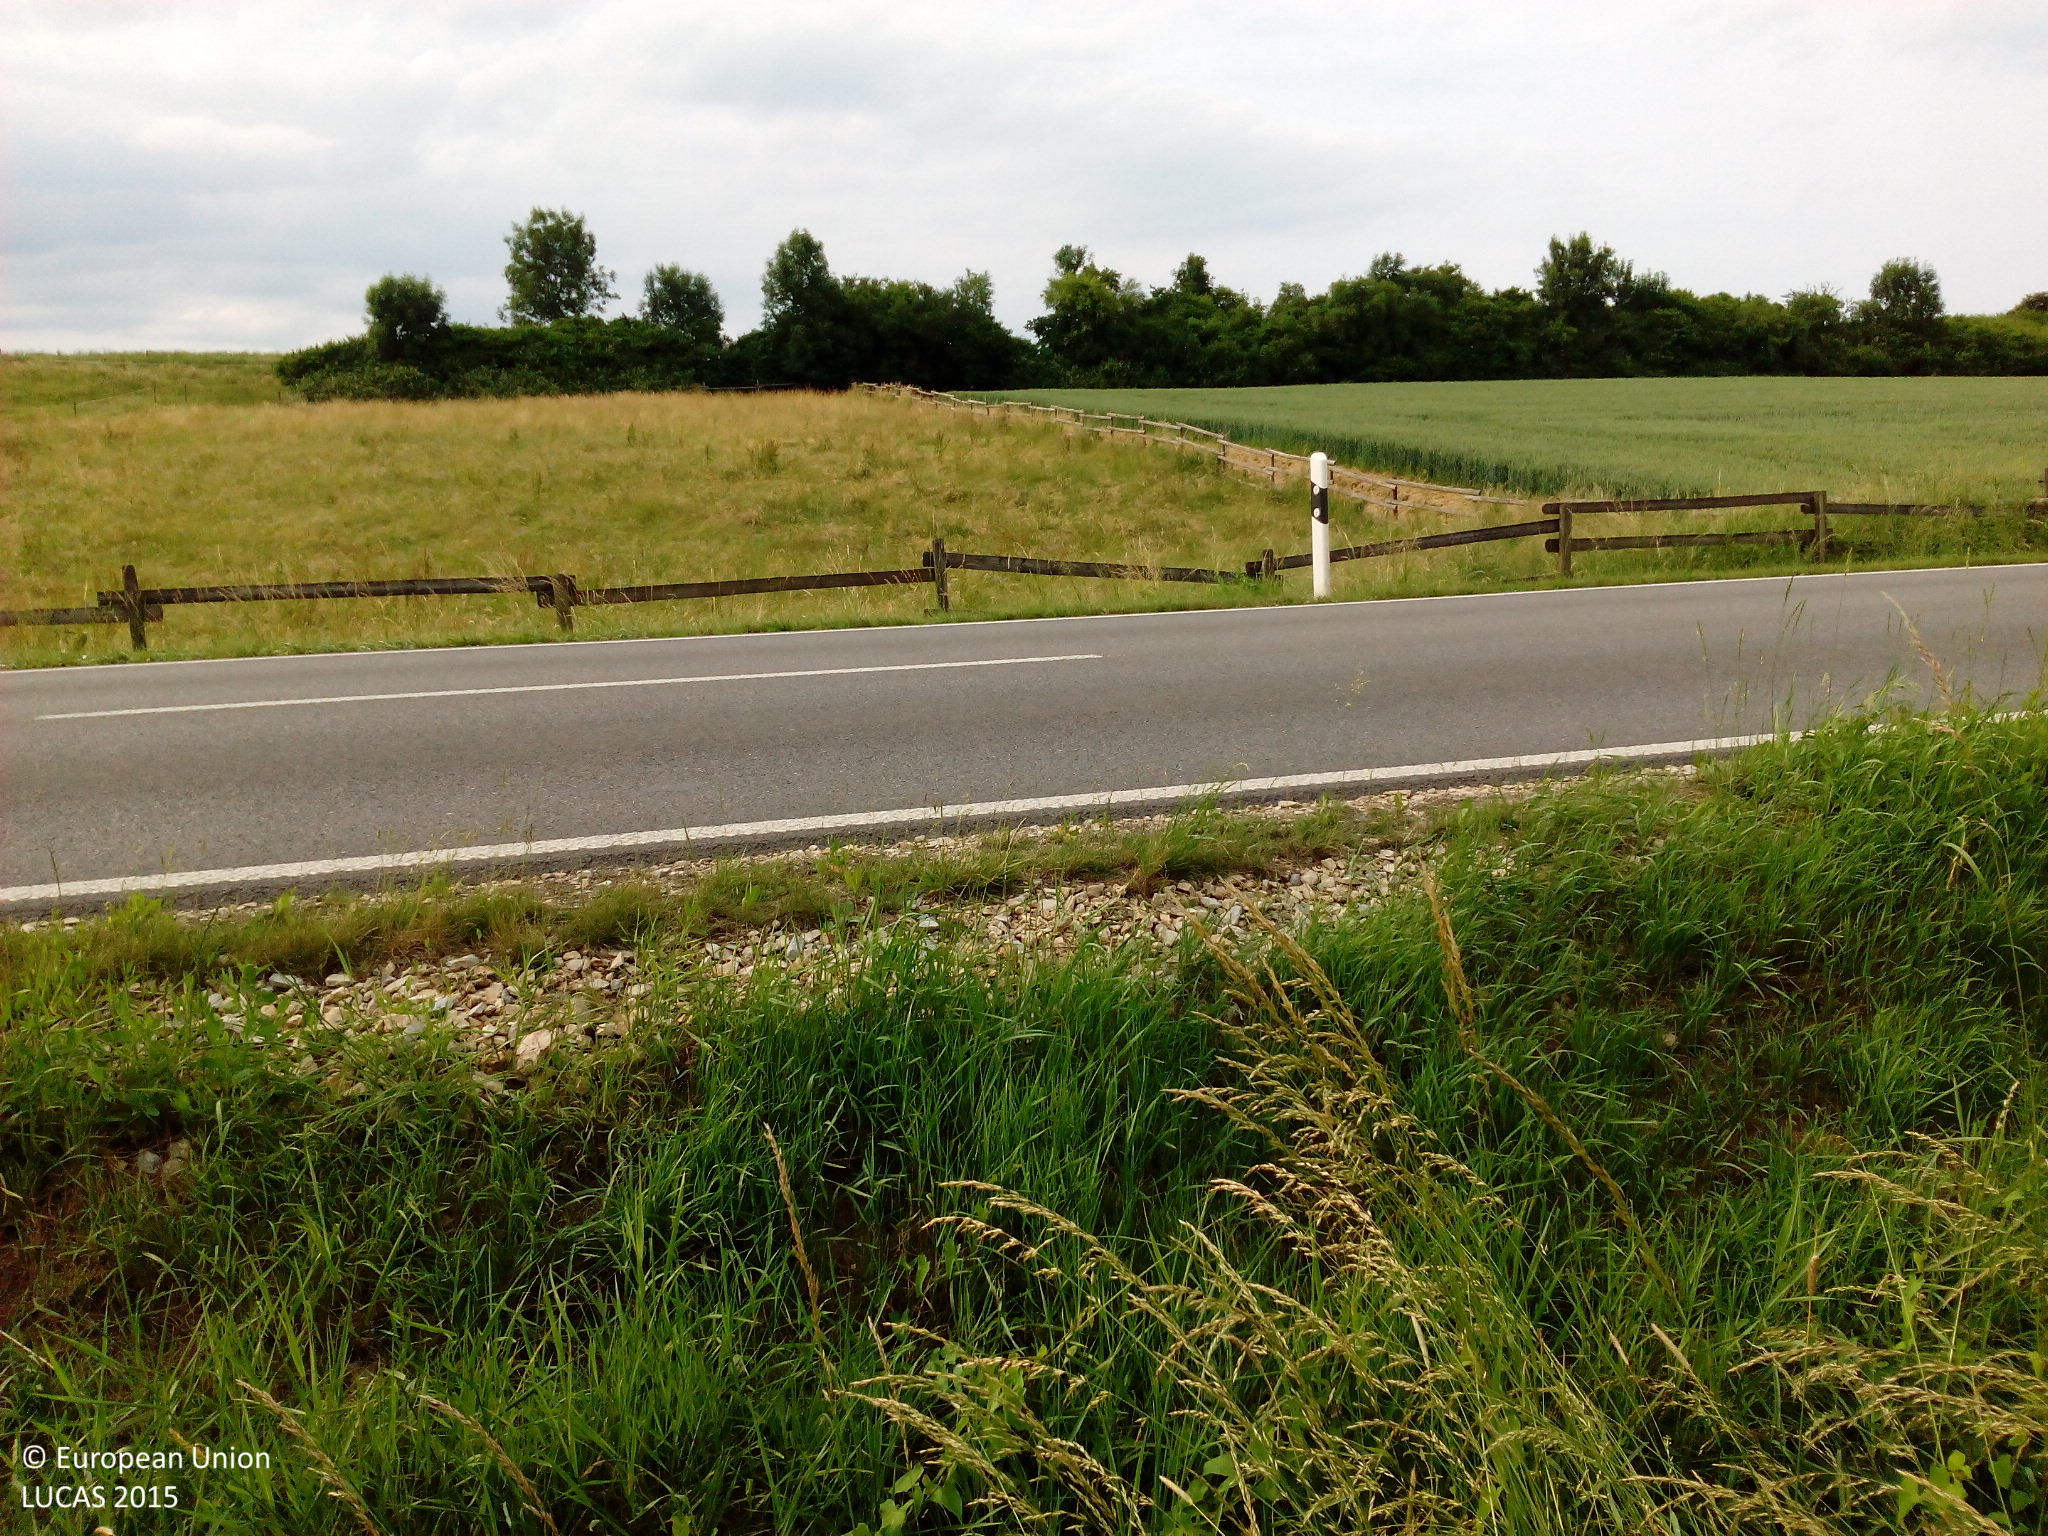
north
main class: Grassland
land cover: Grassland without tree/shrub cover
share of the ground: > 75 %
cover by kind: herbaceous plants 100 %
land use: Semi-natural and natural areas not in use
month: June
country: DE
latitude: 48.6358
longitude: 9.4168
